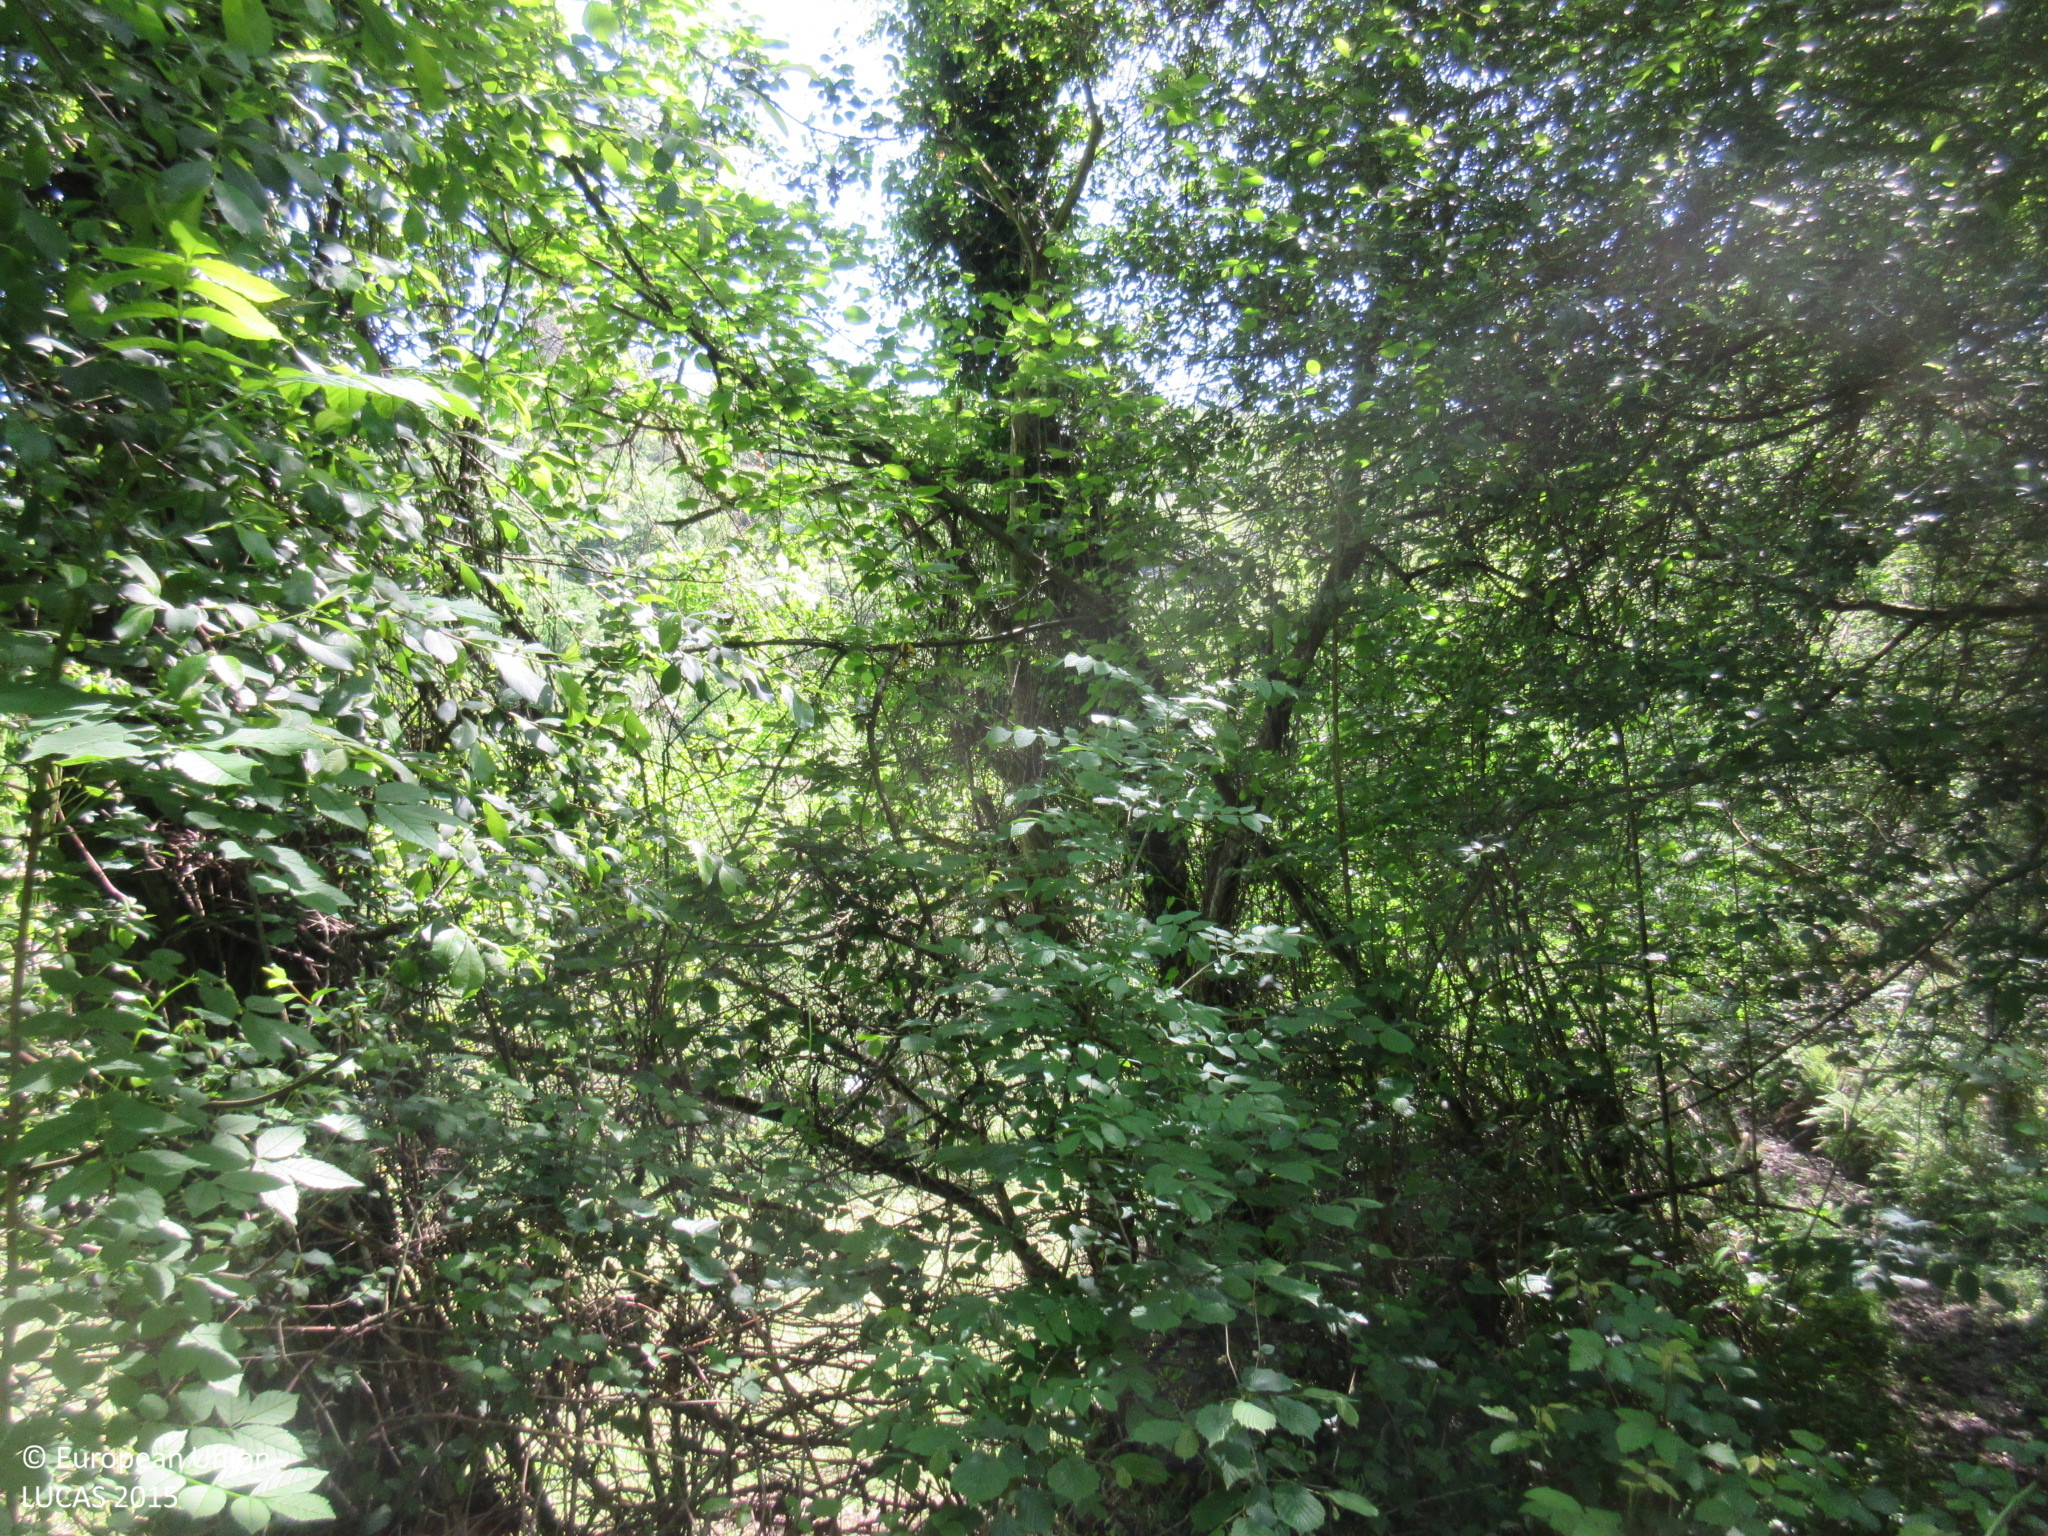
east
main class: Woodland
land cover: Broadleaved woodland
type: acidophilous oak and oak-birch forest
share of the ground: > 75 %
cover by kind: broadleaved forest trees 100 %
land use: Forestry
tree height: > 5 m
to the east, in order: Broadleaved woodland
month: May
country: ES
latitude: 43.3134
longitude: -5.8064
